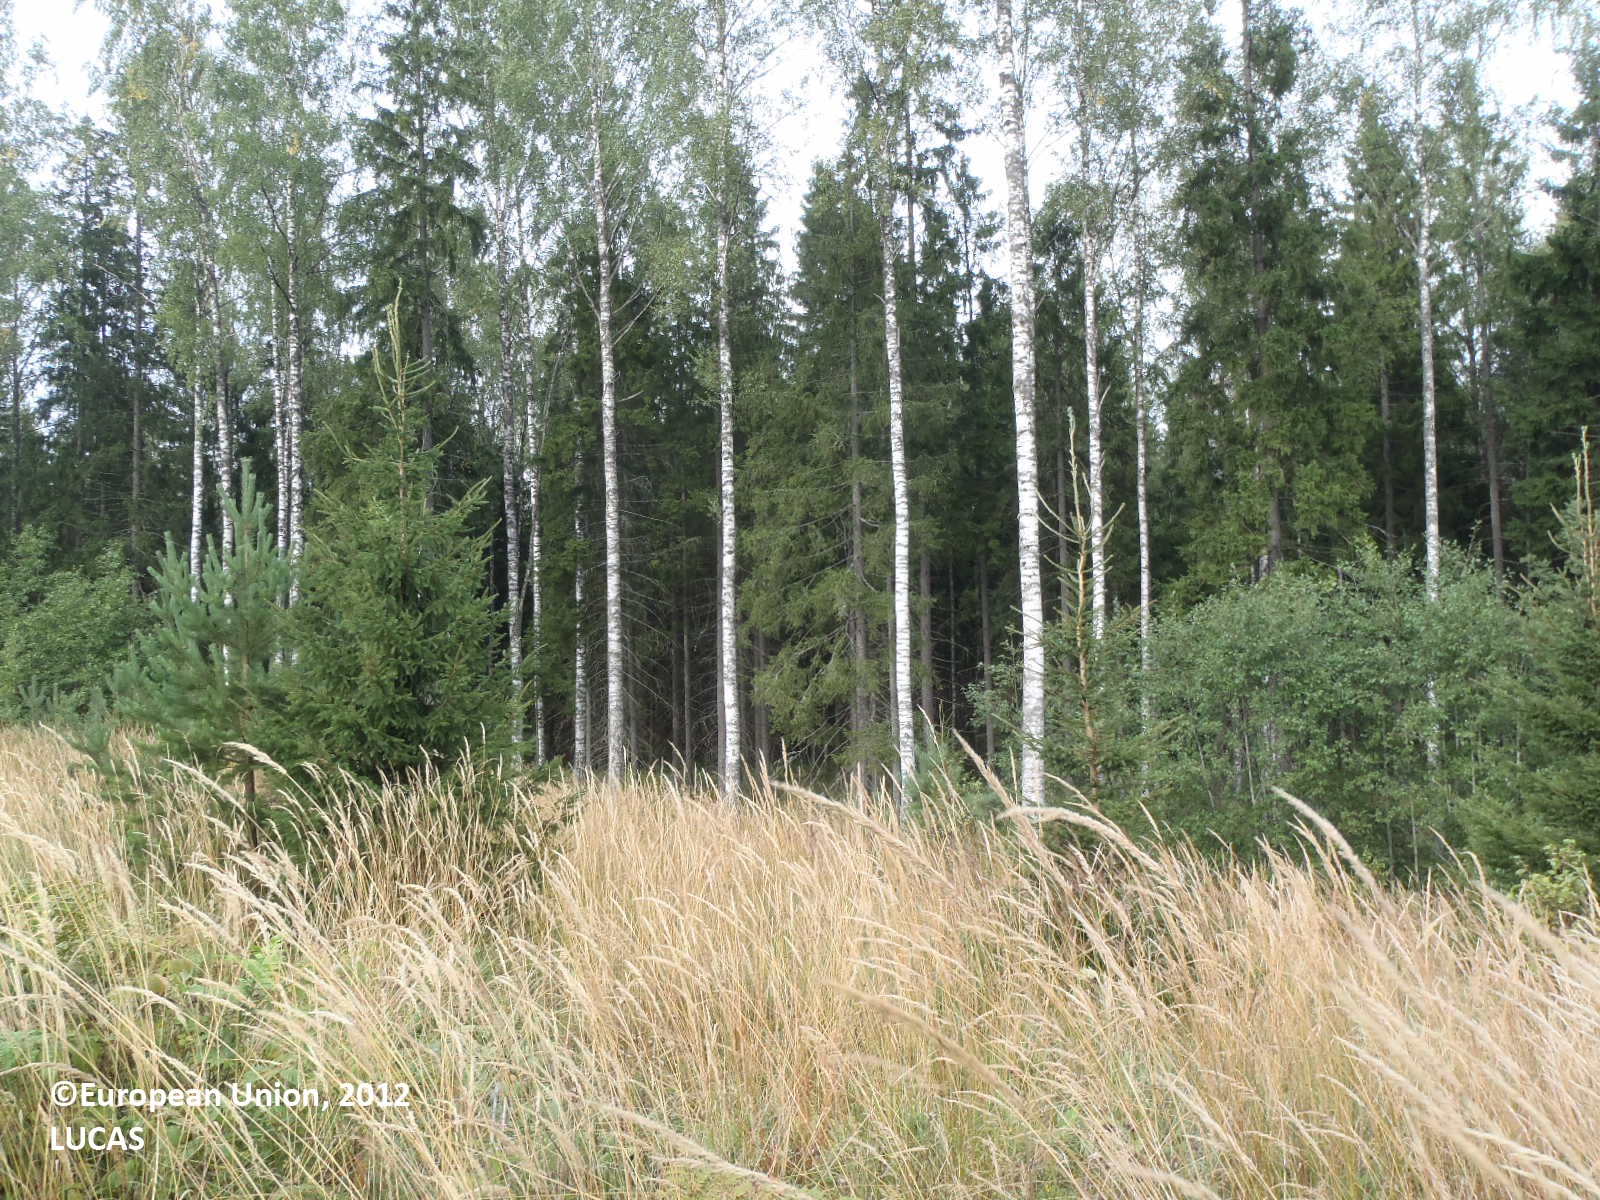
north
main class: Woodland
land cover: Other mixed woodland
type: boreal forest
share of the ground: 25 - 50 %
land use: Forestry
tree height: > 5 m
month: August
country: FI
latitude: 60.7728
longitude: 22.4981
